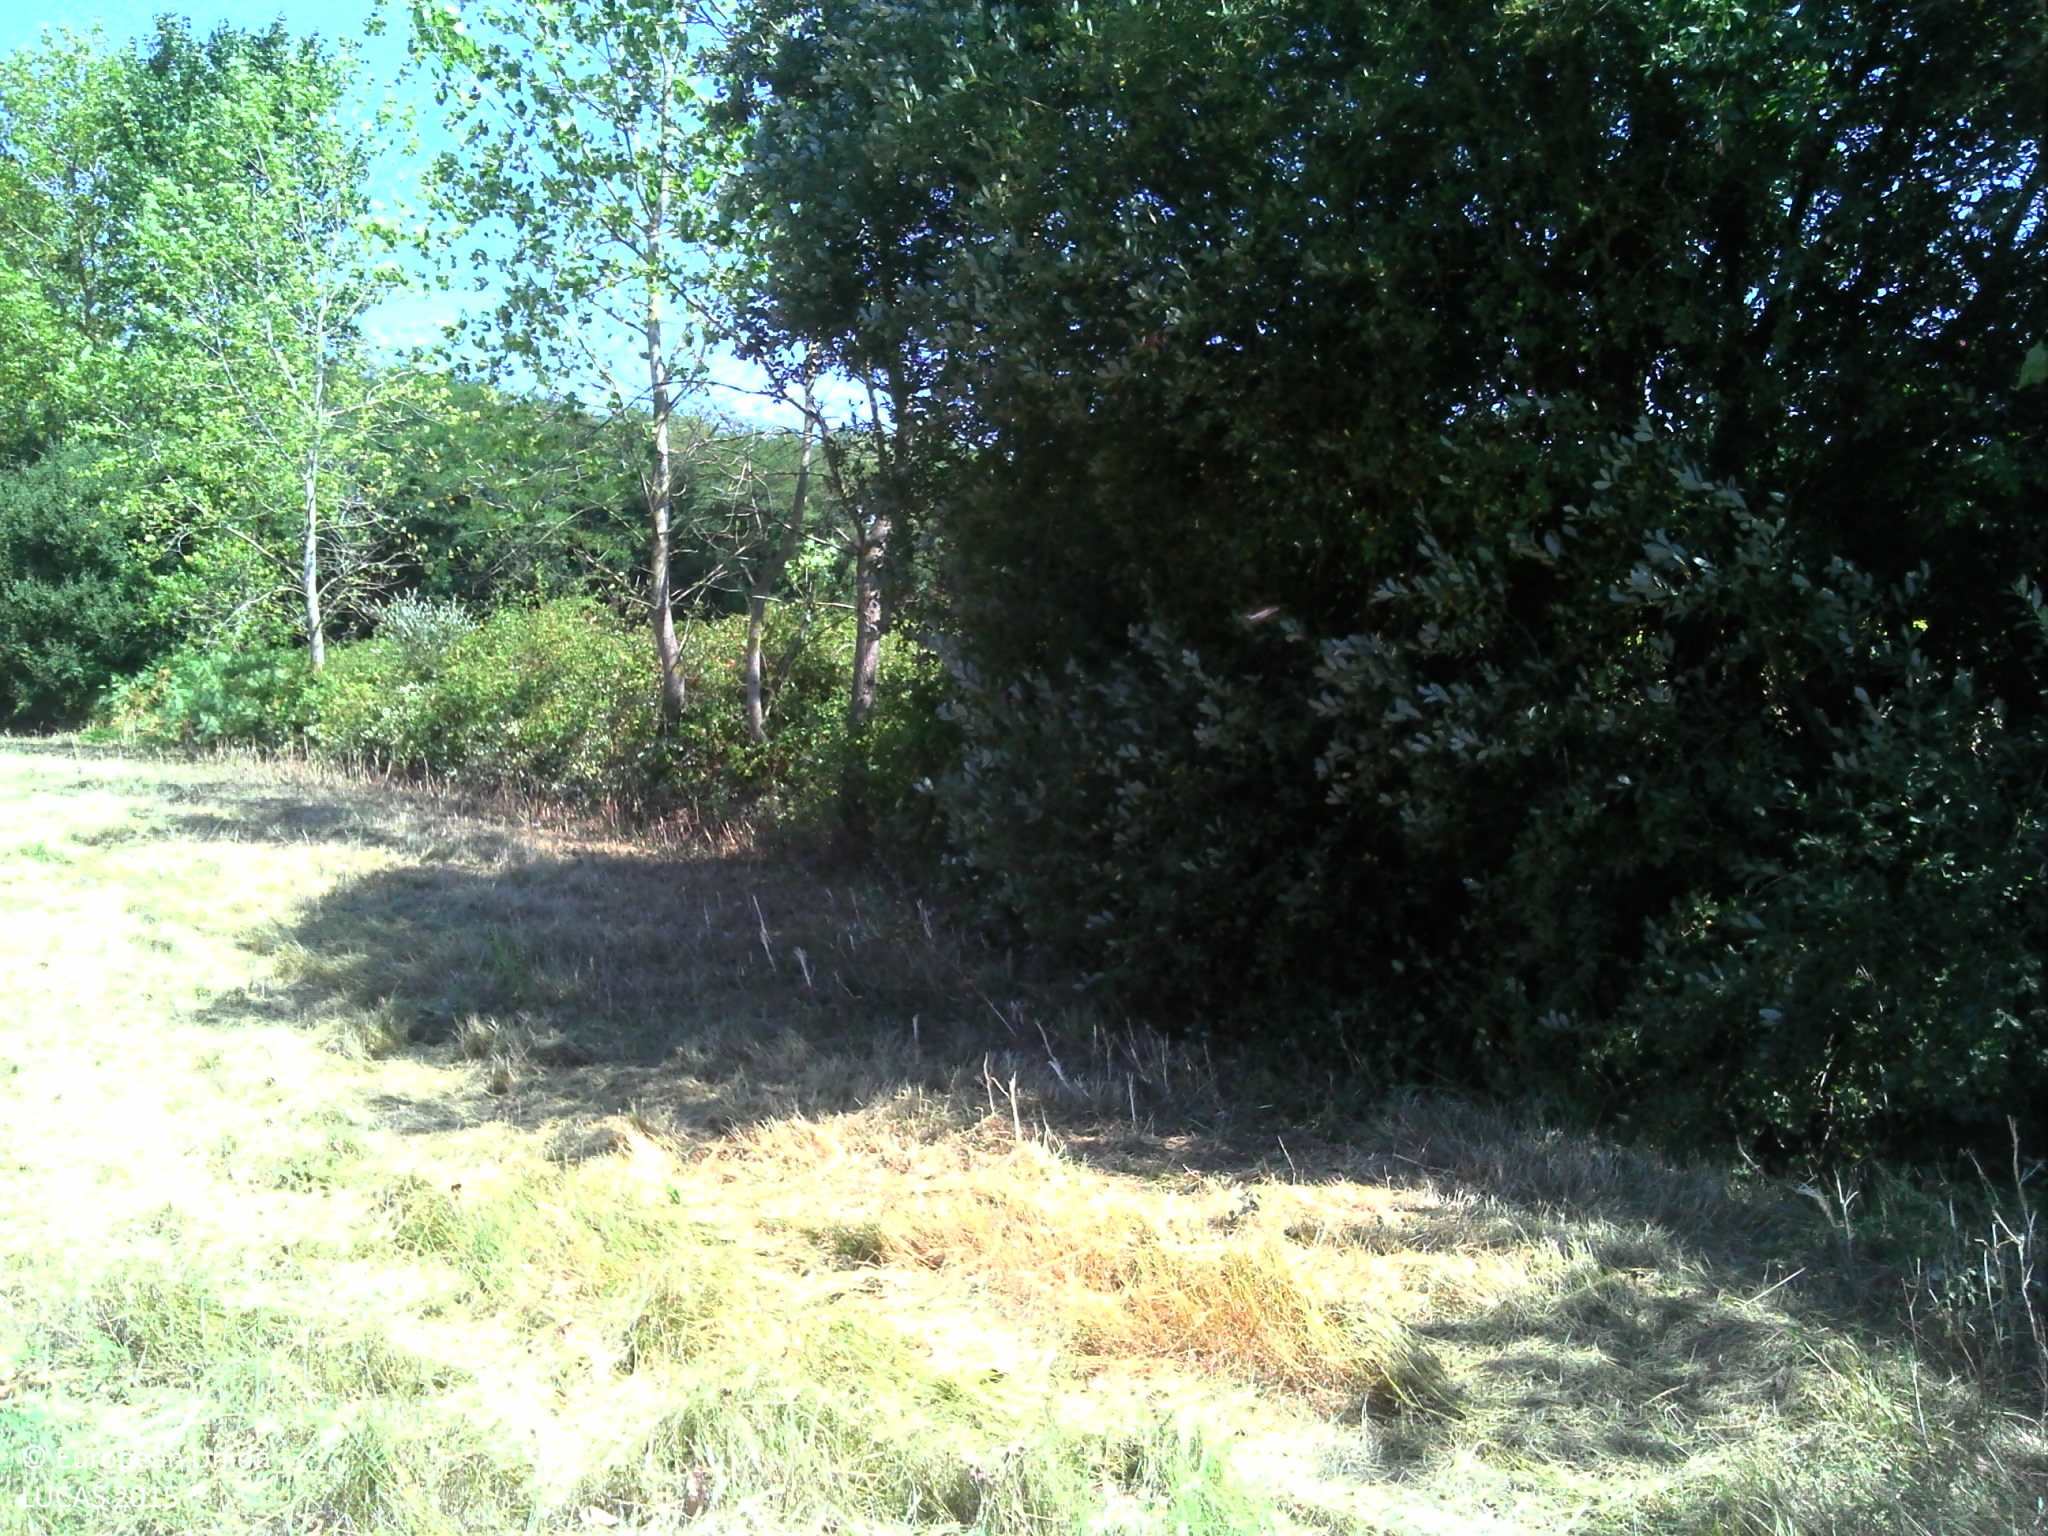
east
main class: Cropland
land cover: Dry pulses
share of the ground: 25 - 50 %
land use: Agriculture (excluding fallow land and kitchen gardens)
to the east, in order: Dry pulses; Grassland without tree/shrub cover; Lines of trees; Ditches and canals; Shruby margins; Dry pulses; Broadleaved woodland; Tracks; Broadleaved woodland; Grassland without tree/shrub cover
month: August
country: FR
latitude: 46.7737
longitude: -1.0740
